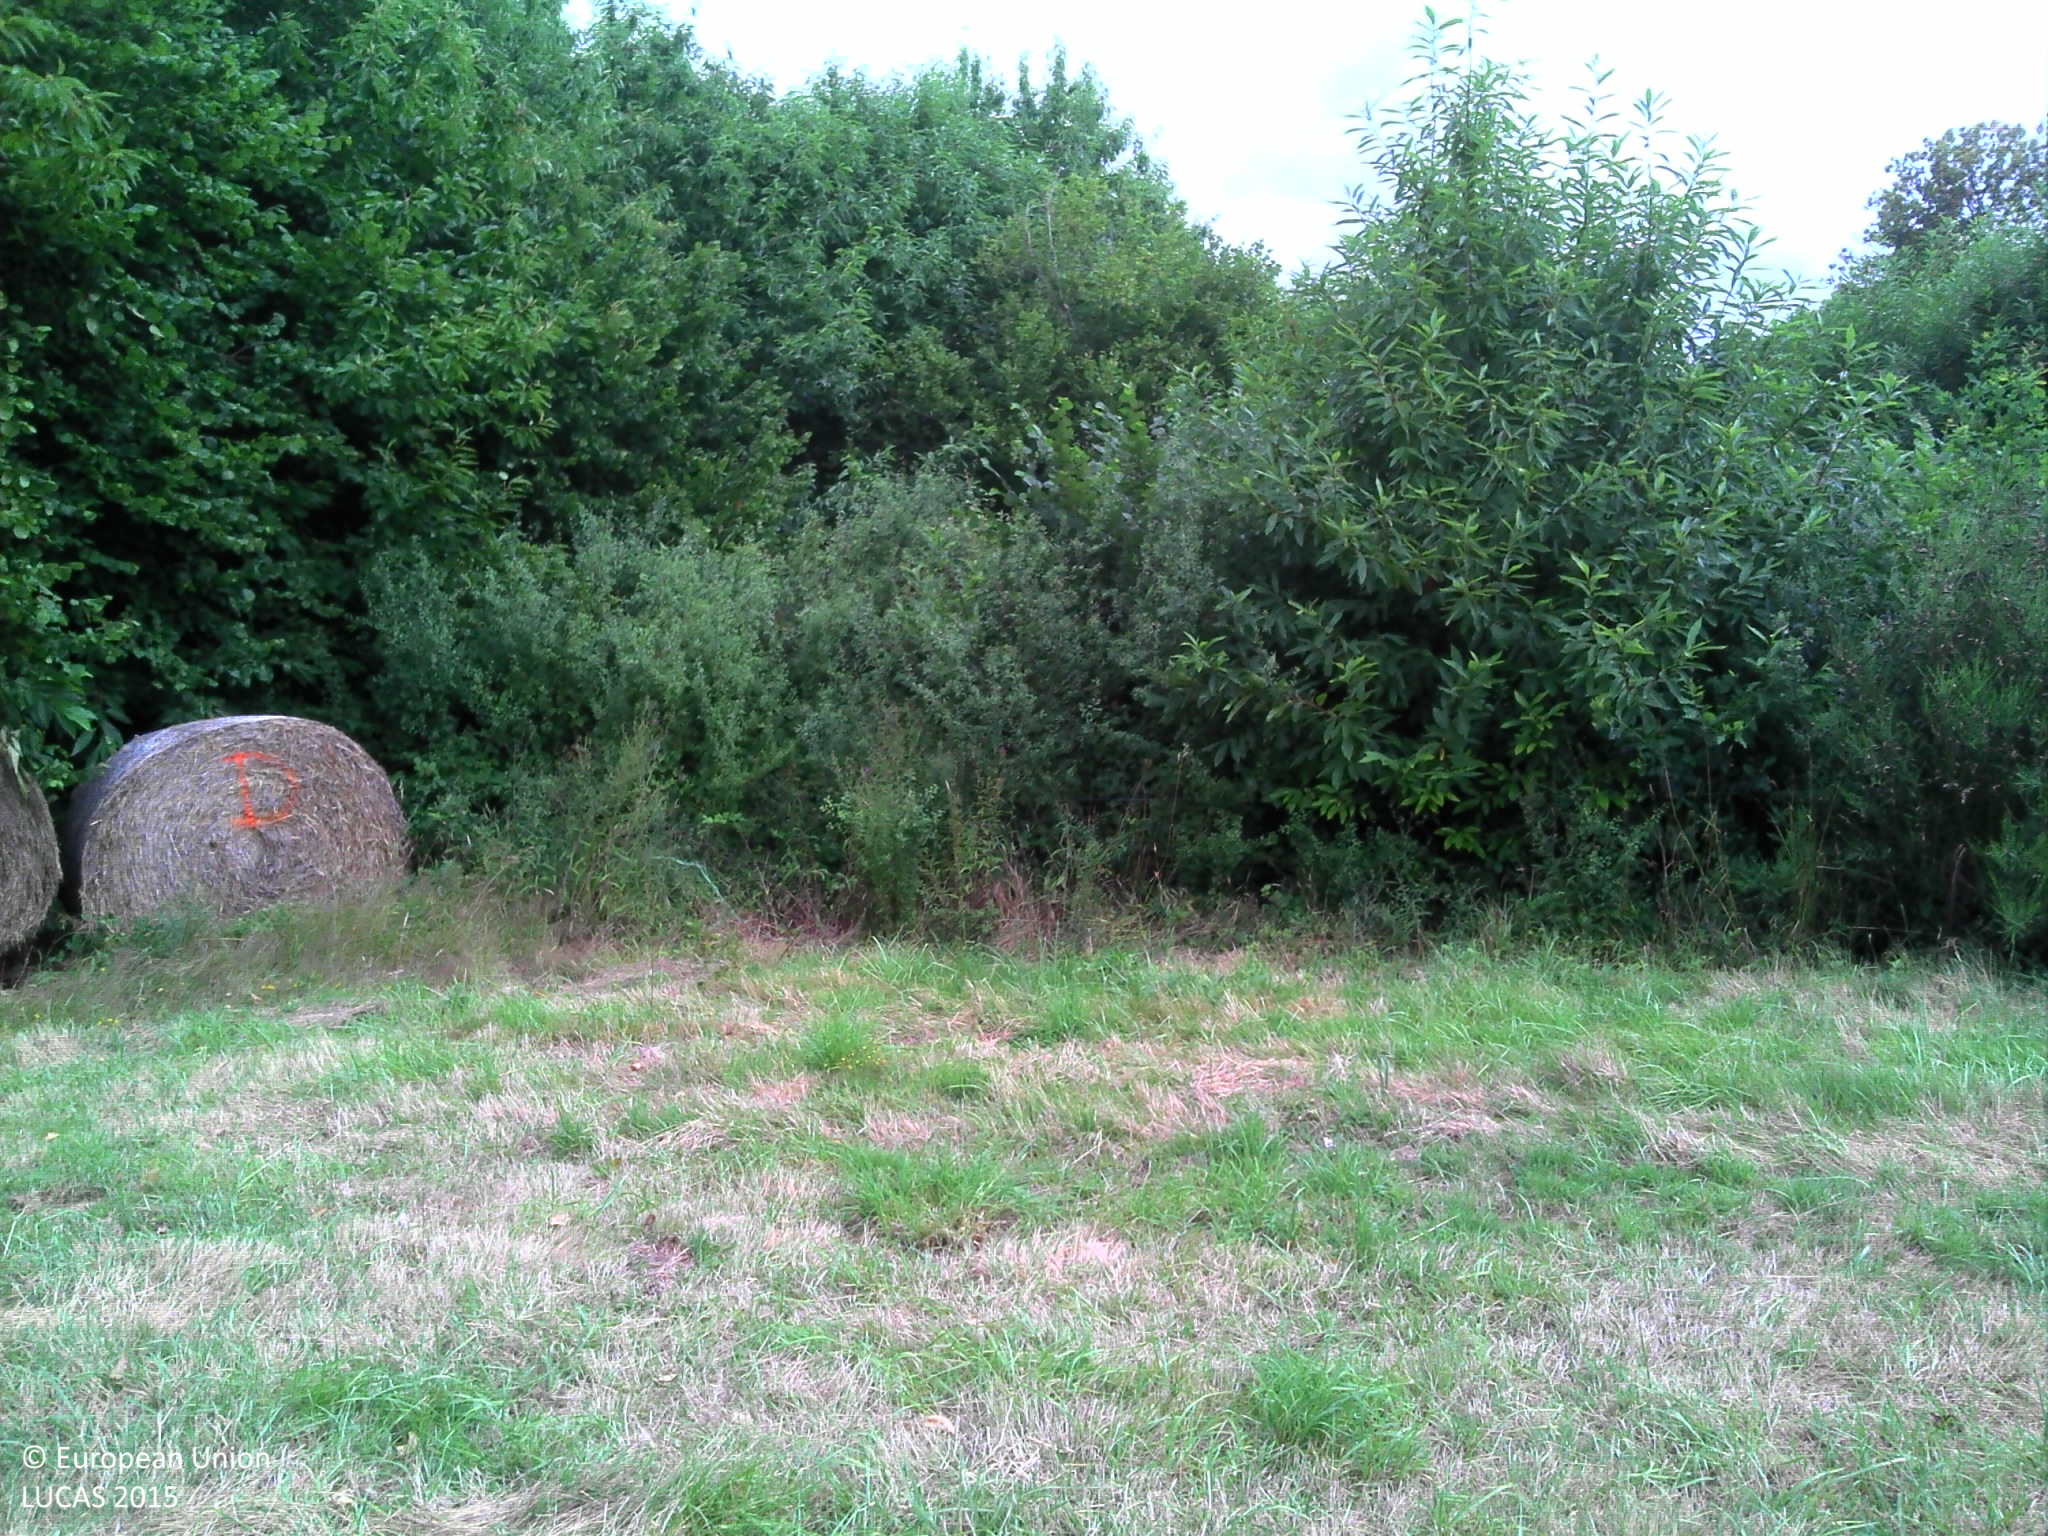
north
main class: Grassland
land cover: Grassland without tree/shrub cover
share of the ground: > 75 %
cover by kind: herbaceous plants 100 %
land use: Agriculture (excluding fallow land and kitchen gardens)
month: July
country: FR
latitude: 47.5654
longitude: -1.9991
